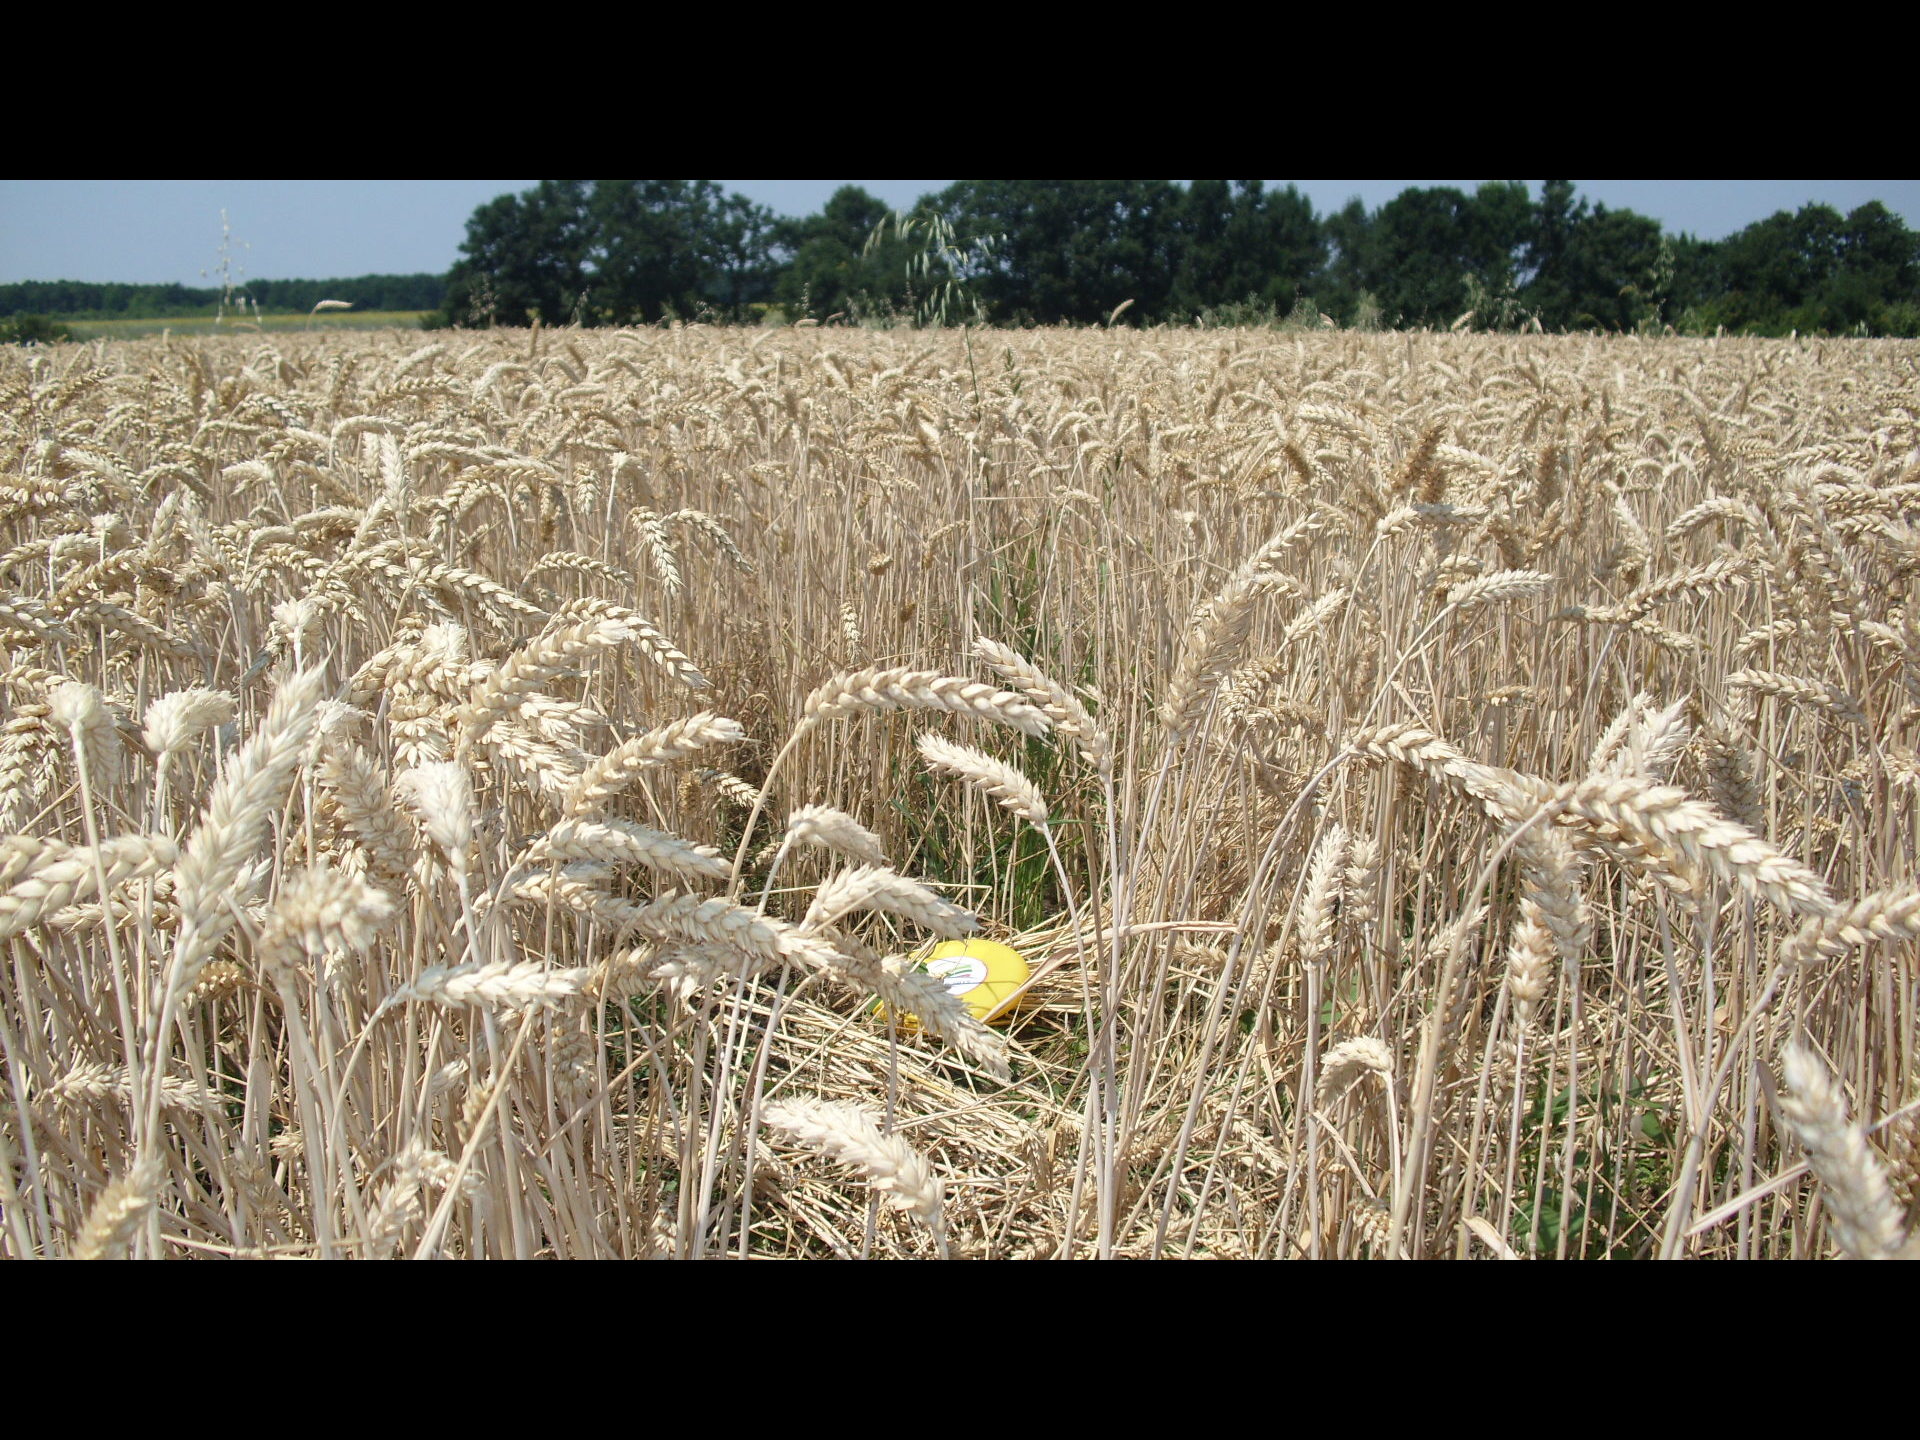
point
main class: Cropland
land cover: Common wheat
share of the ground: > 75 %
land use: Agriculture (excluding fallow land and kitchen gardens)
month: July
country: BG
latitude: 43.7081
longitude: 22.8818
